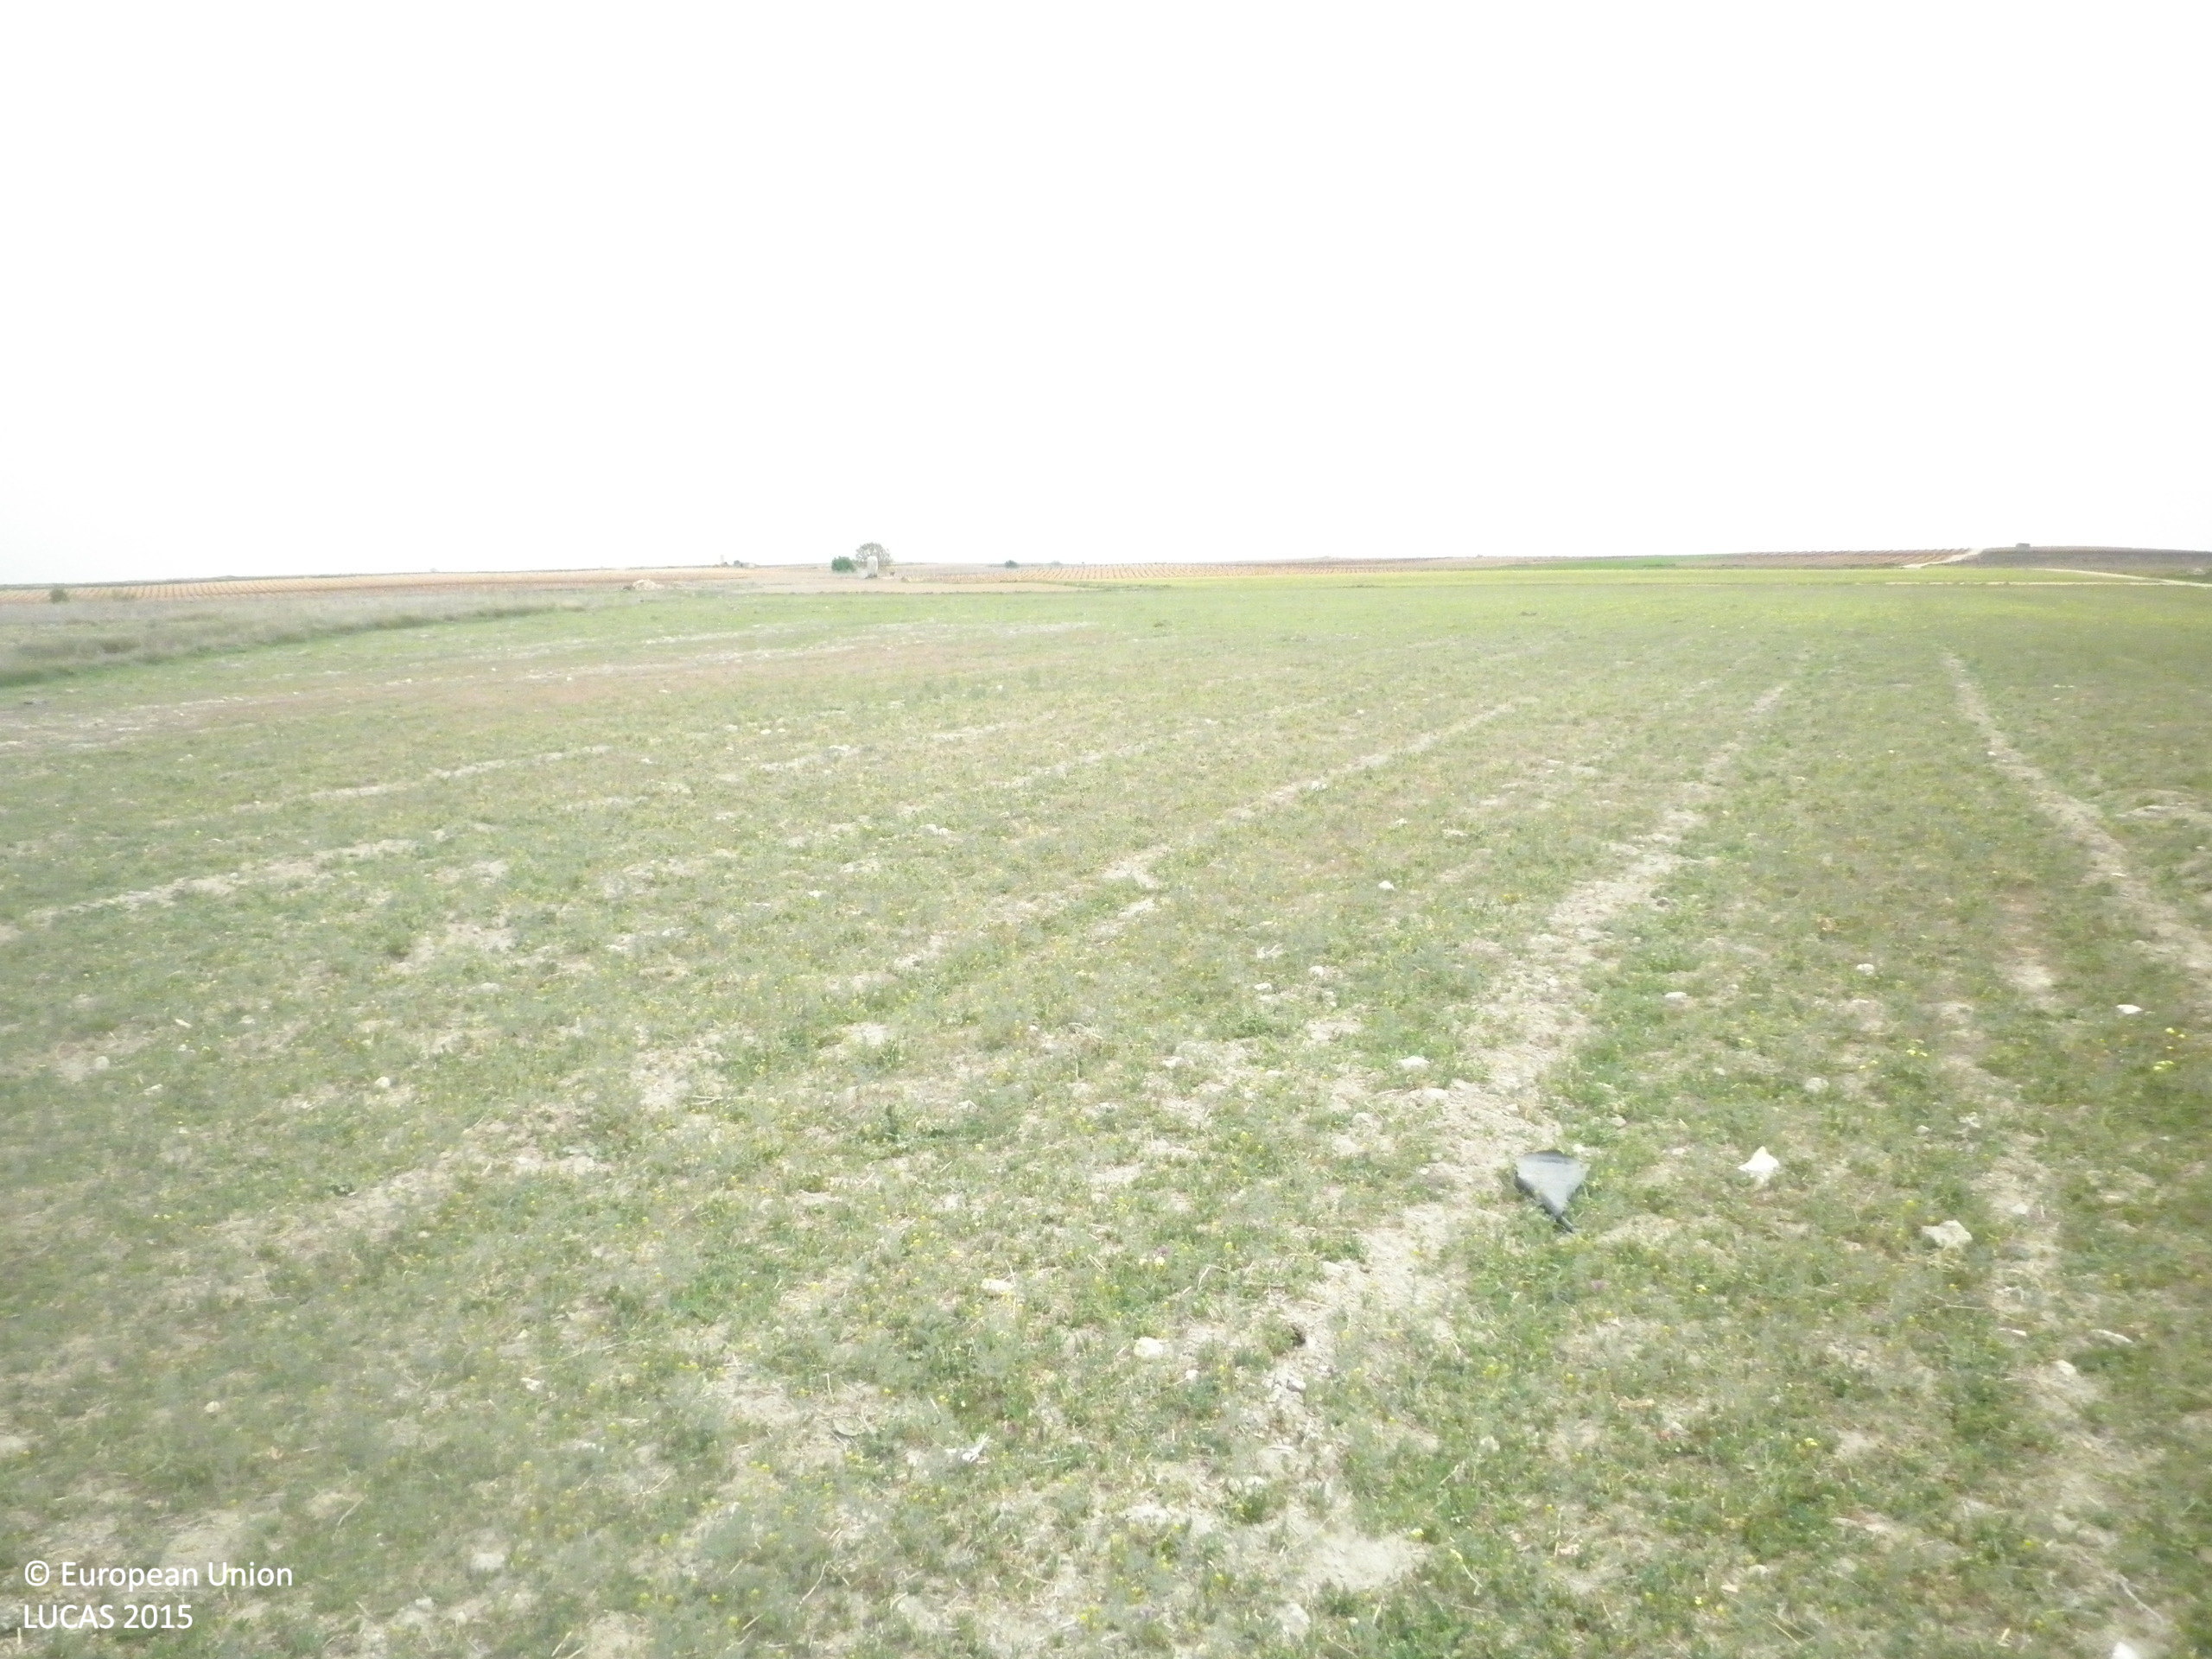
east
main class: Grassland
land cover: Grassland without tree/shrub cover
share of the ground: 50 - 75 %
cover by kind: herbaceous plants 60 %, unconsolidated bare surface 40 %
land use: Agriculture (excluding fallow land and kitchen gardens)
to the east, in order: Grassland without tree/shrub cover; Grass margins; Tracks; Grass margins; Grassland without tree/shrub cover; Vineyards
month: April
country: ES
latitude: 39.3950
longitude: -2.7510
